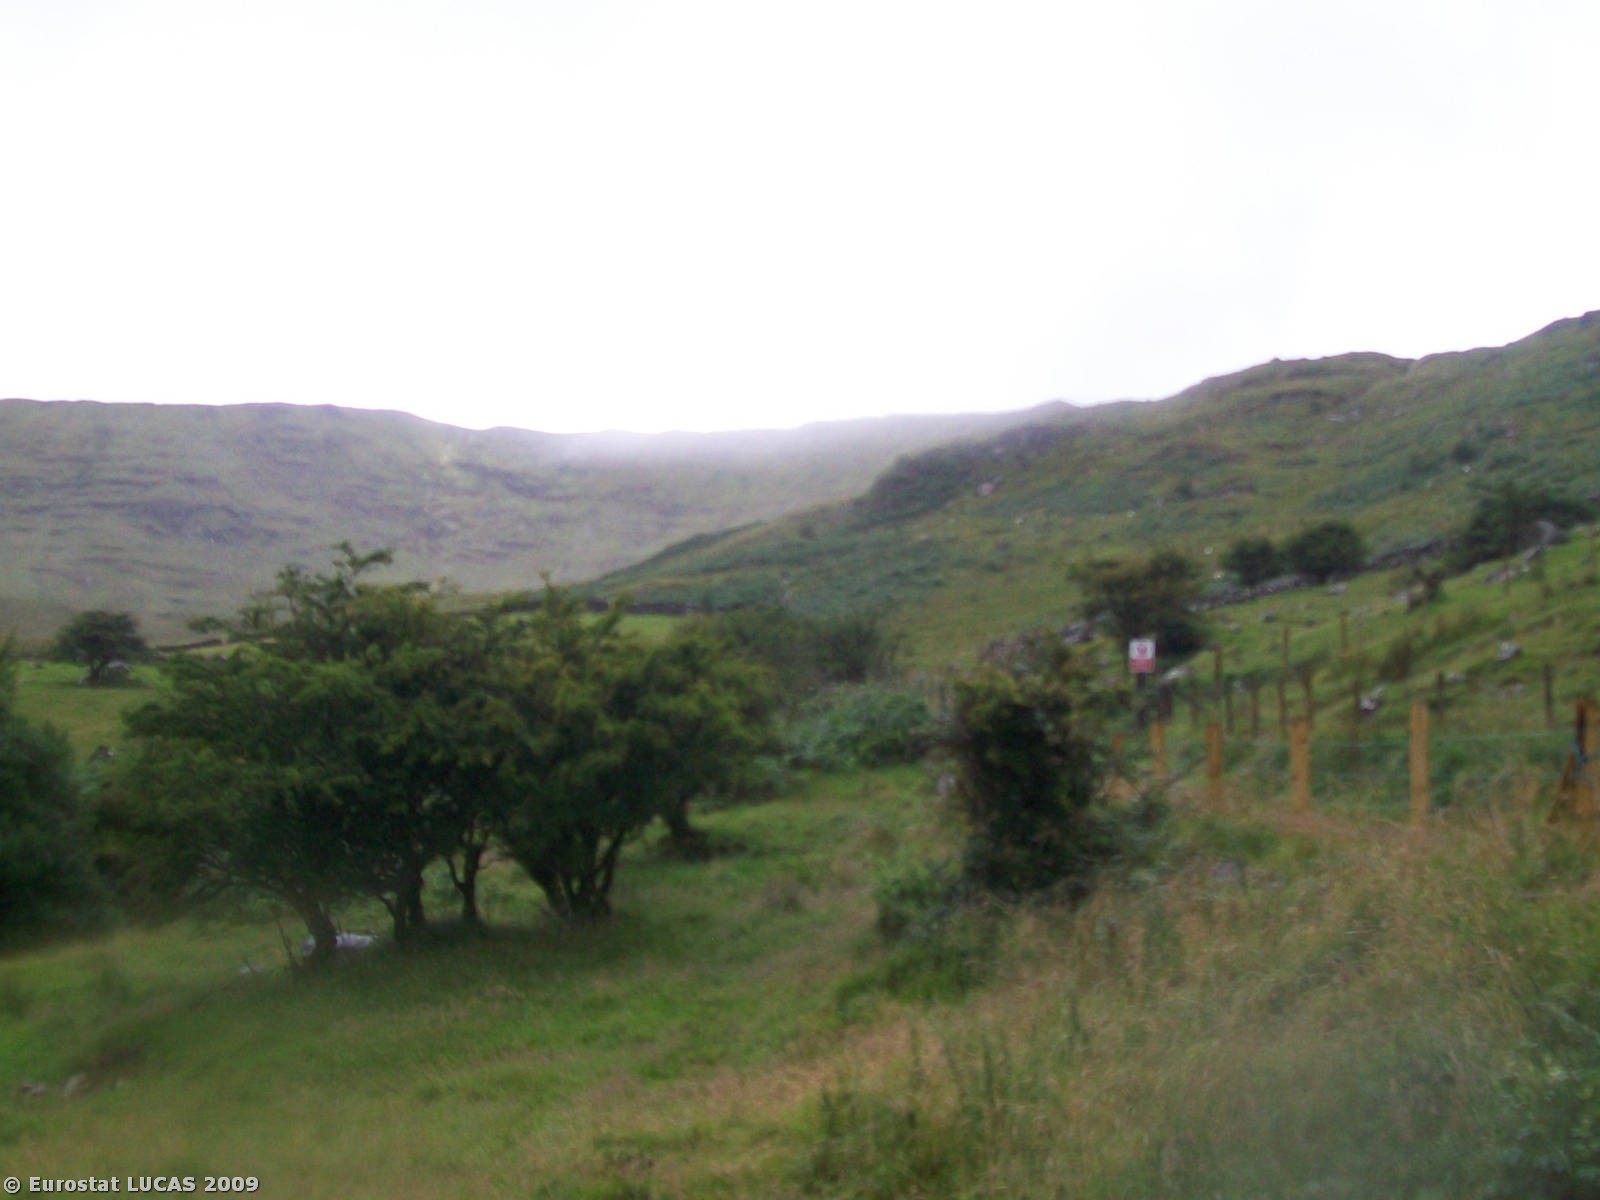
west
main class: Grassland
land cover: Grassland without tree/shrub cover
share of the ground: > 75 %
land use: Agriculture (excluding fallow land and kitchen gardens)
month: July
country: IE
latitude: 53.5433
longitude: -9.5666
